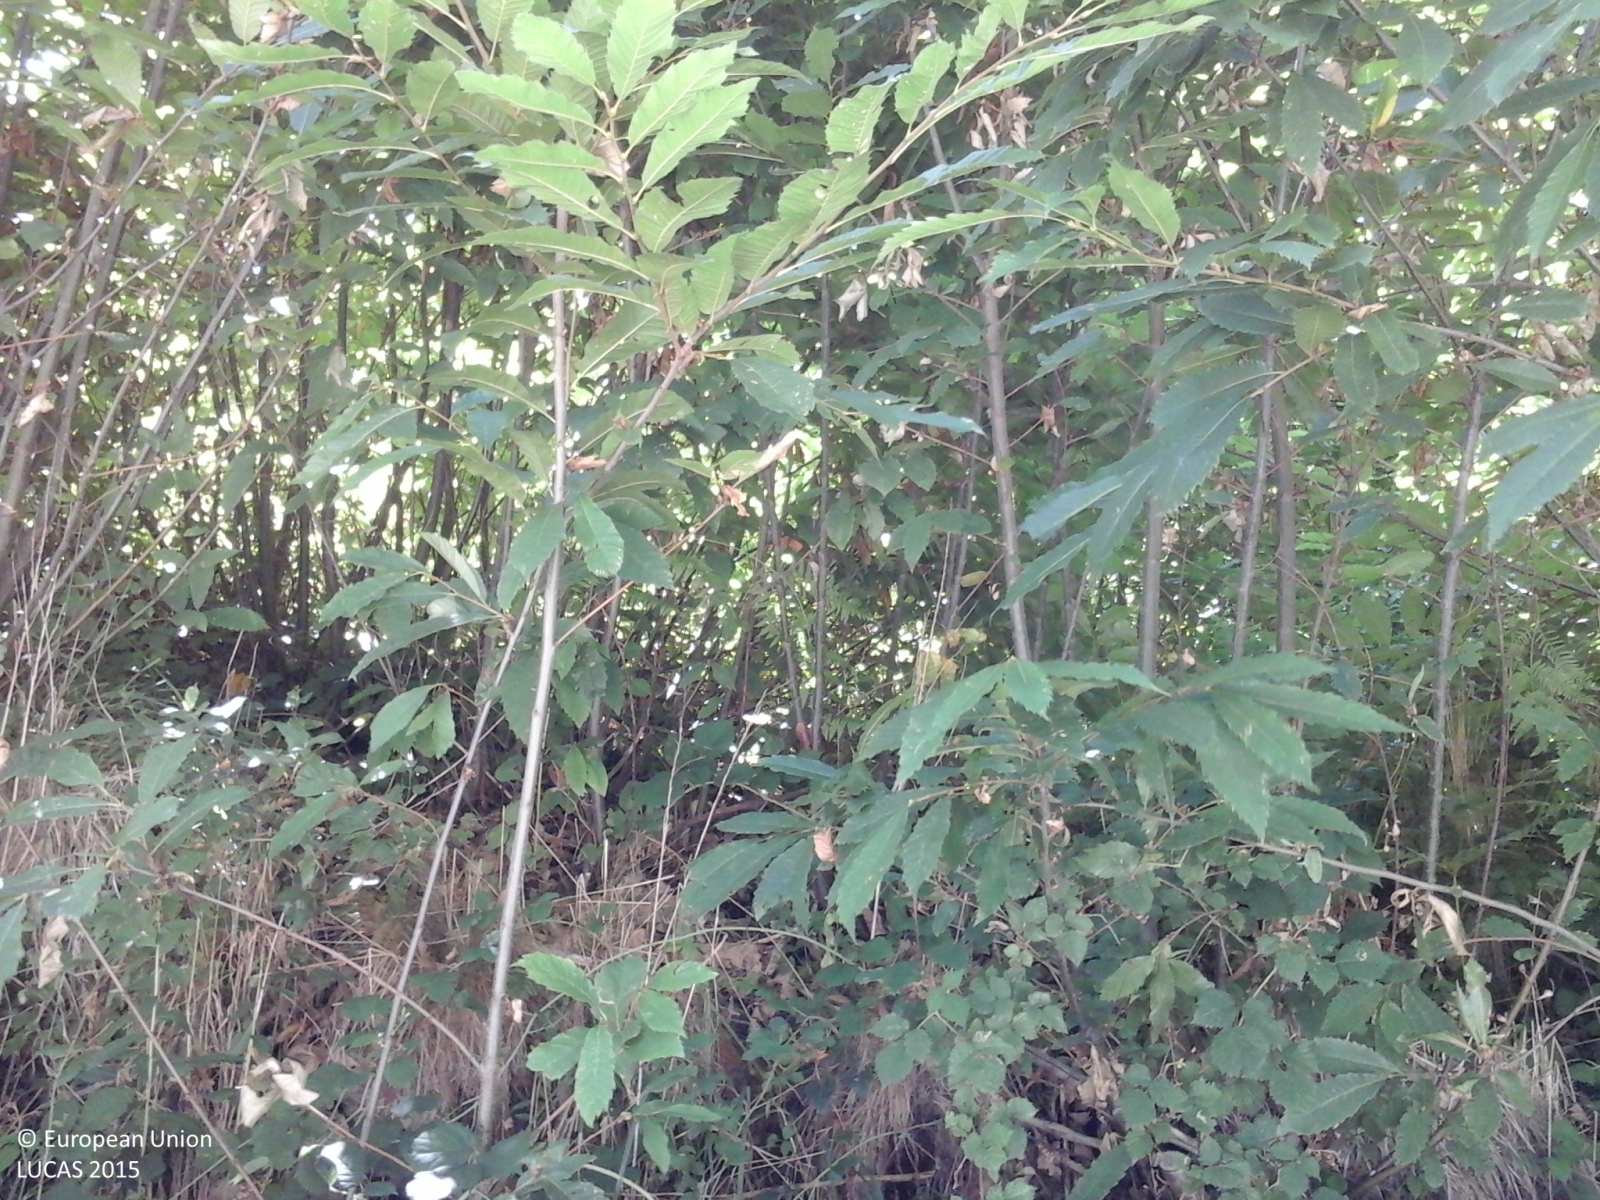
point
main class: Woodland
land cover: Broadleaved woodland
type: thermophilous deciduous forest
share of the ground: > 75 %
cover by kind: broadleaved forest trees 100 %
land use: Forestry
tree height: > 5 m
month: August
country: IT
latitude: 40.2451
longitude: 15.0675
